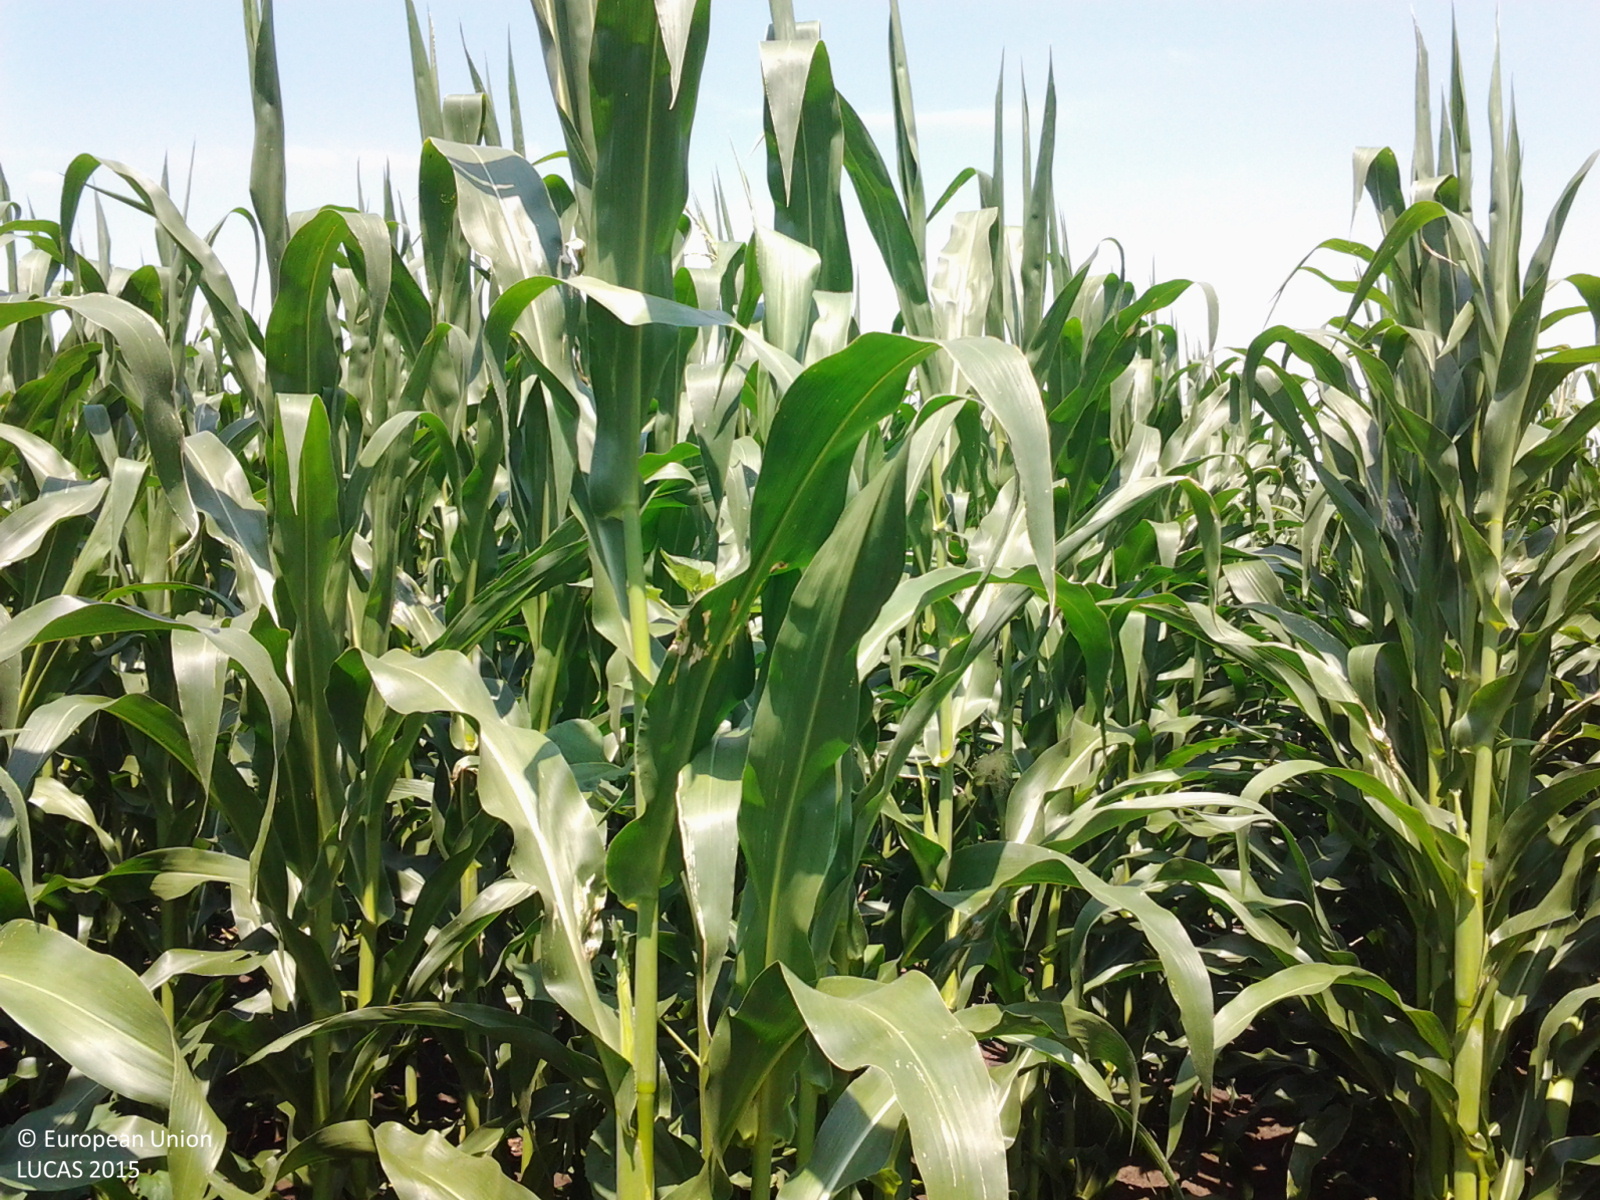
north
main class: Cropland
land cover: Maize
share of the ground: > 75 %
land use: Agriculture (excluding fallow land and kitchen gardens)
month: July
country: HU
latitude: 47.5285
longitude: 19.8403
